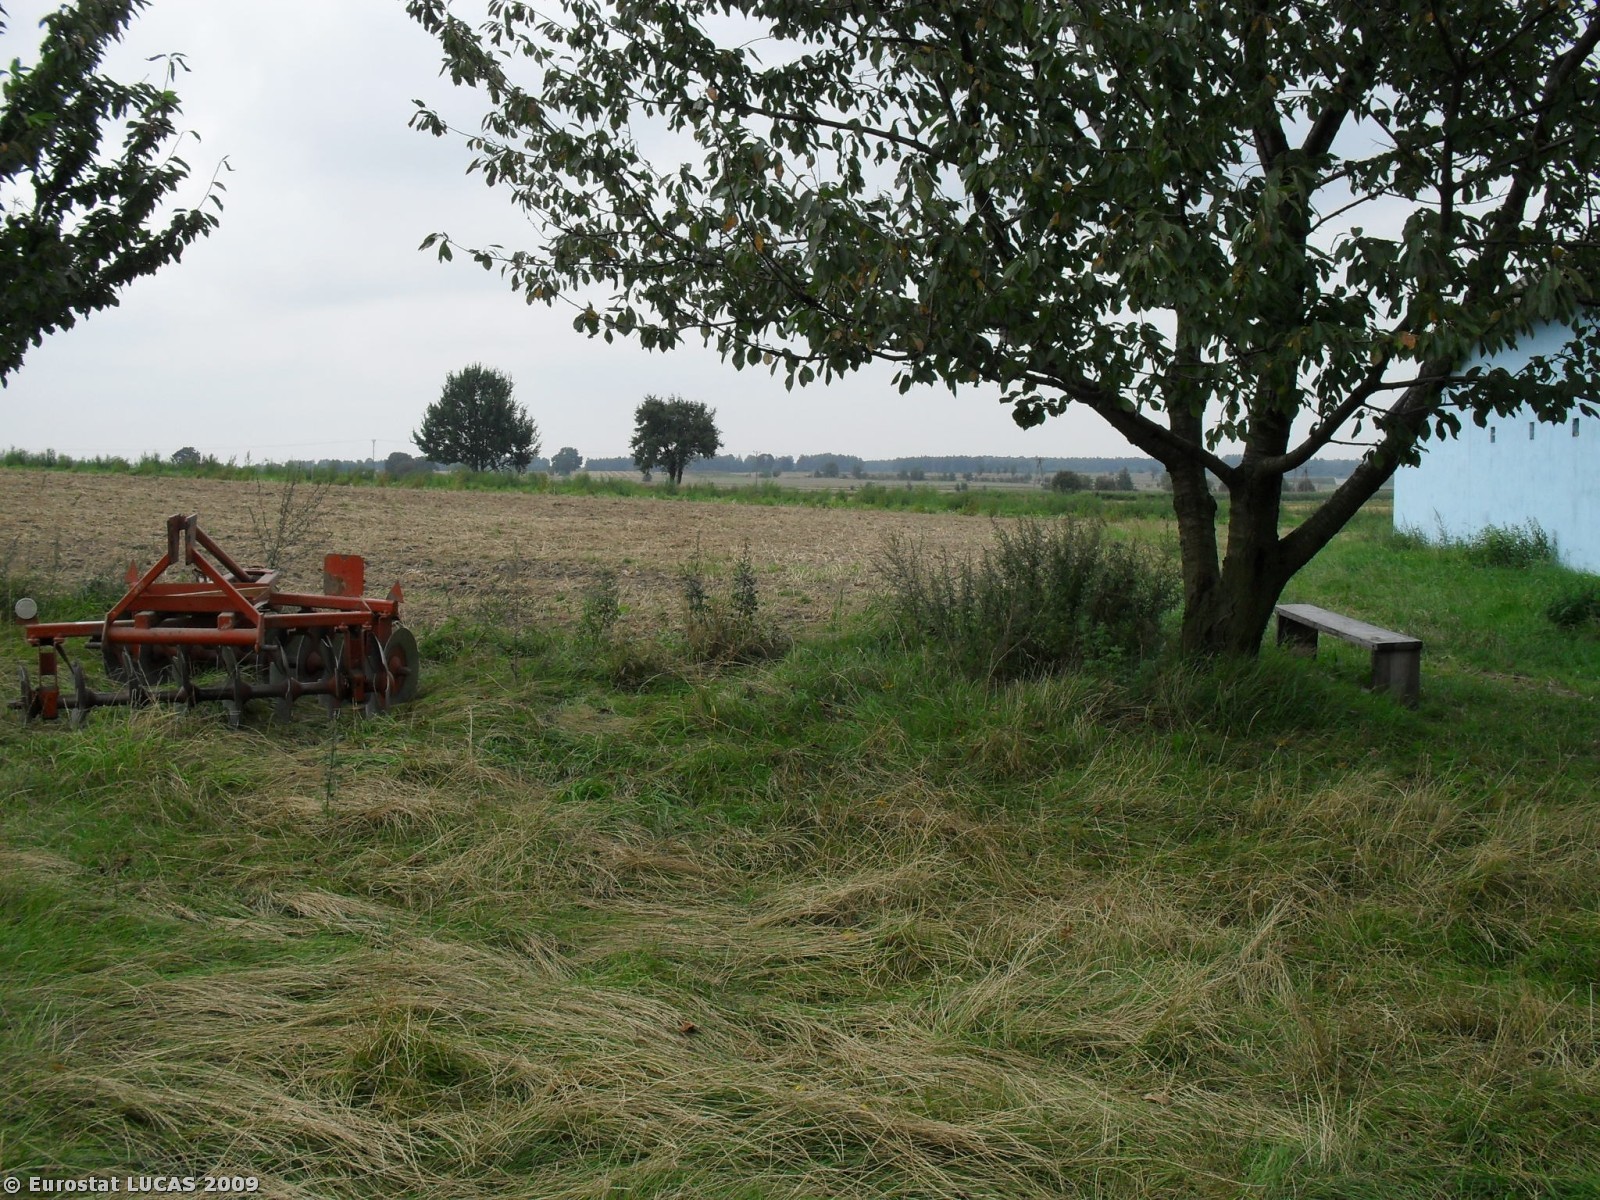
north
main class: Grassland
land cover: Grassland without tree/shrub cover
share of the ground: > 75 %
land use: Agriculture (excluding fallow land and kitchen gardens)
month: August
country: PL
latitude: 51.8905
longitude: 19.4576
